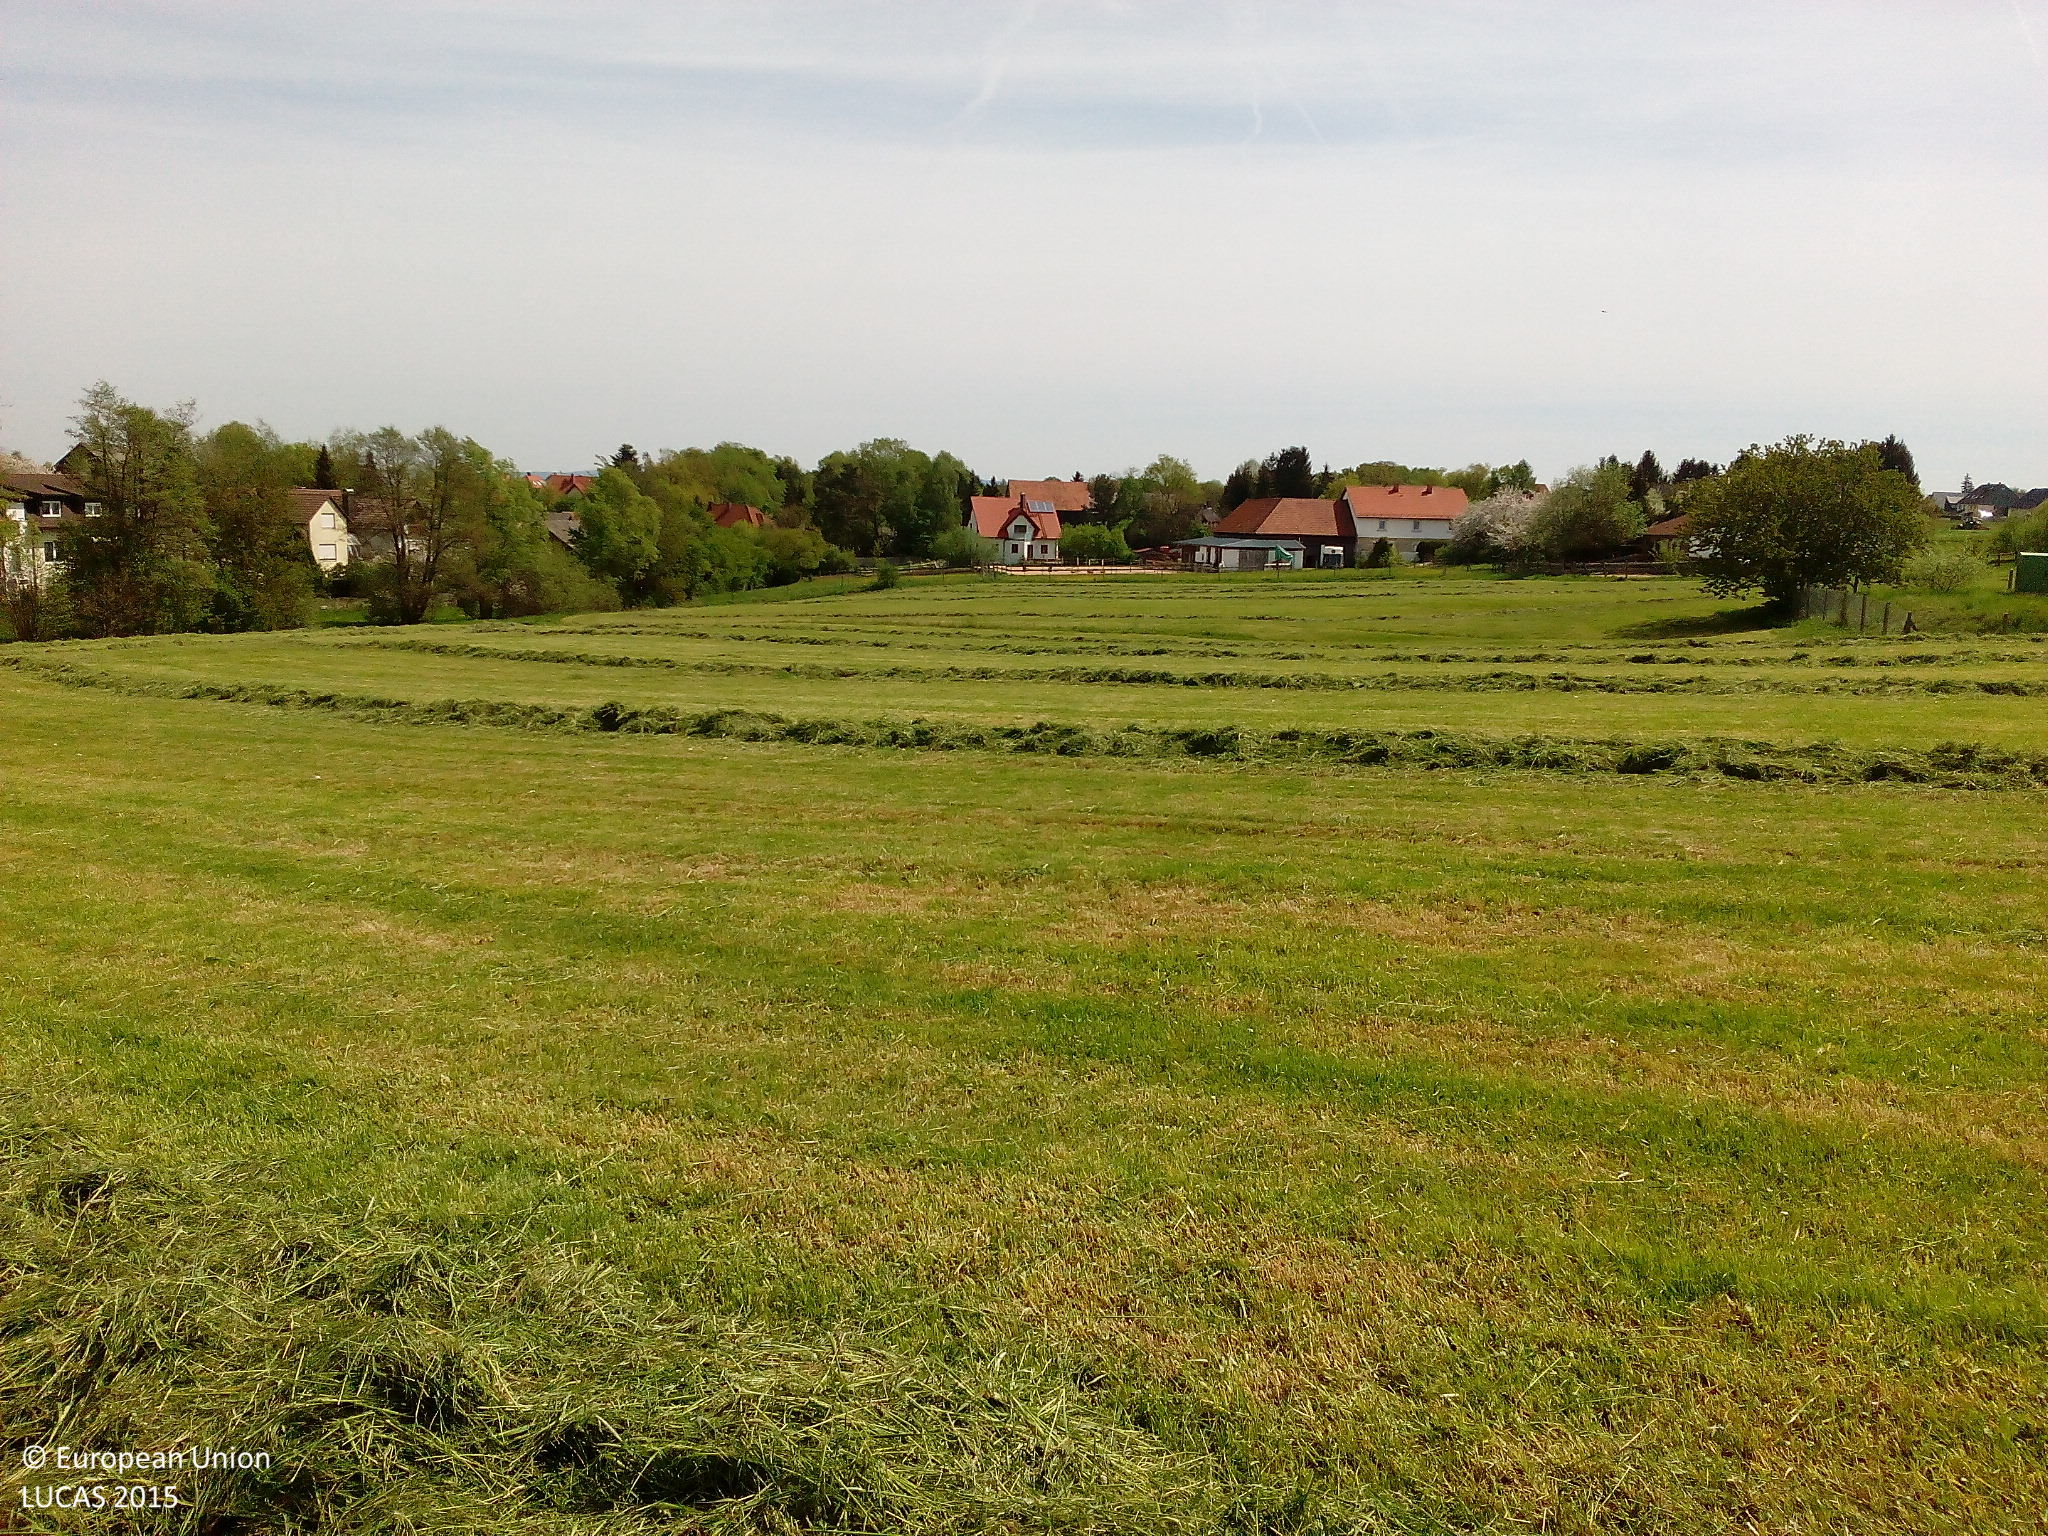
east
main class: Grassland
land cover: Grassland without tree/shrub cover
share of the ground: > 75 %
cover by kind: herbaceous plants 100 %
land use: Agriculture (excluding fallow land and kitchen gardens)
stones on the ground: < 10 %
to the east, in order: Grassland without tree/shrub cover; Artificial constructions in urban areas
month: May
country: DE
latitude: 49.9410
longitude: 11.4627
